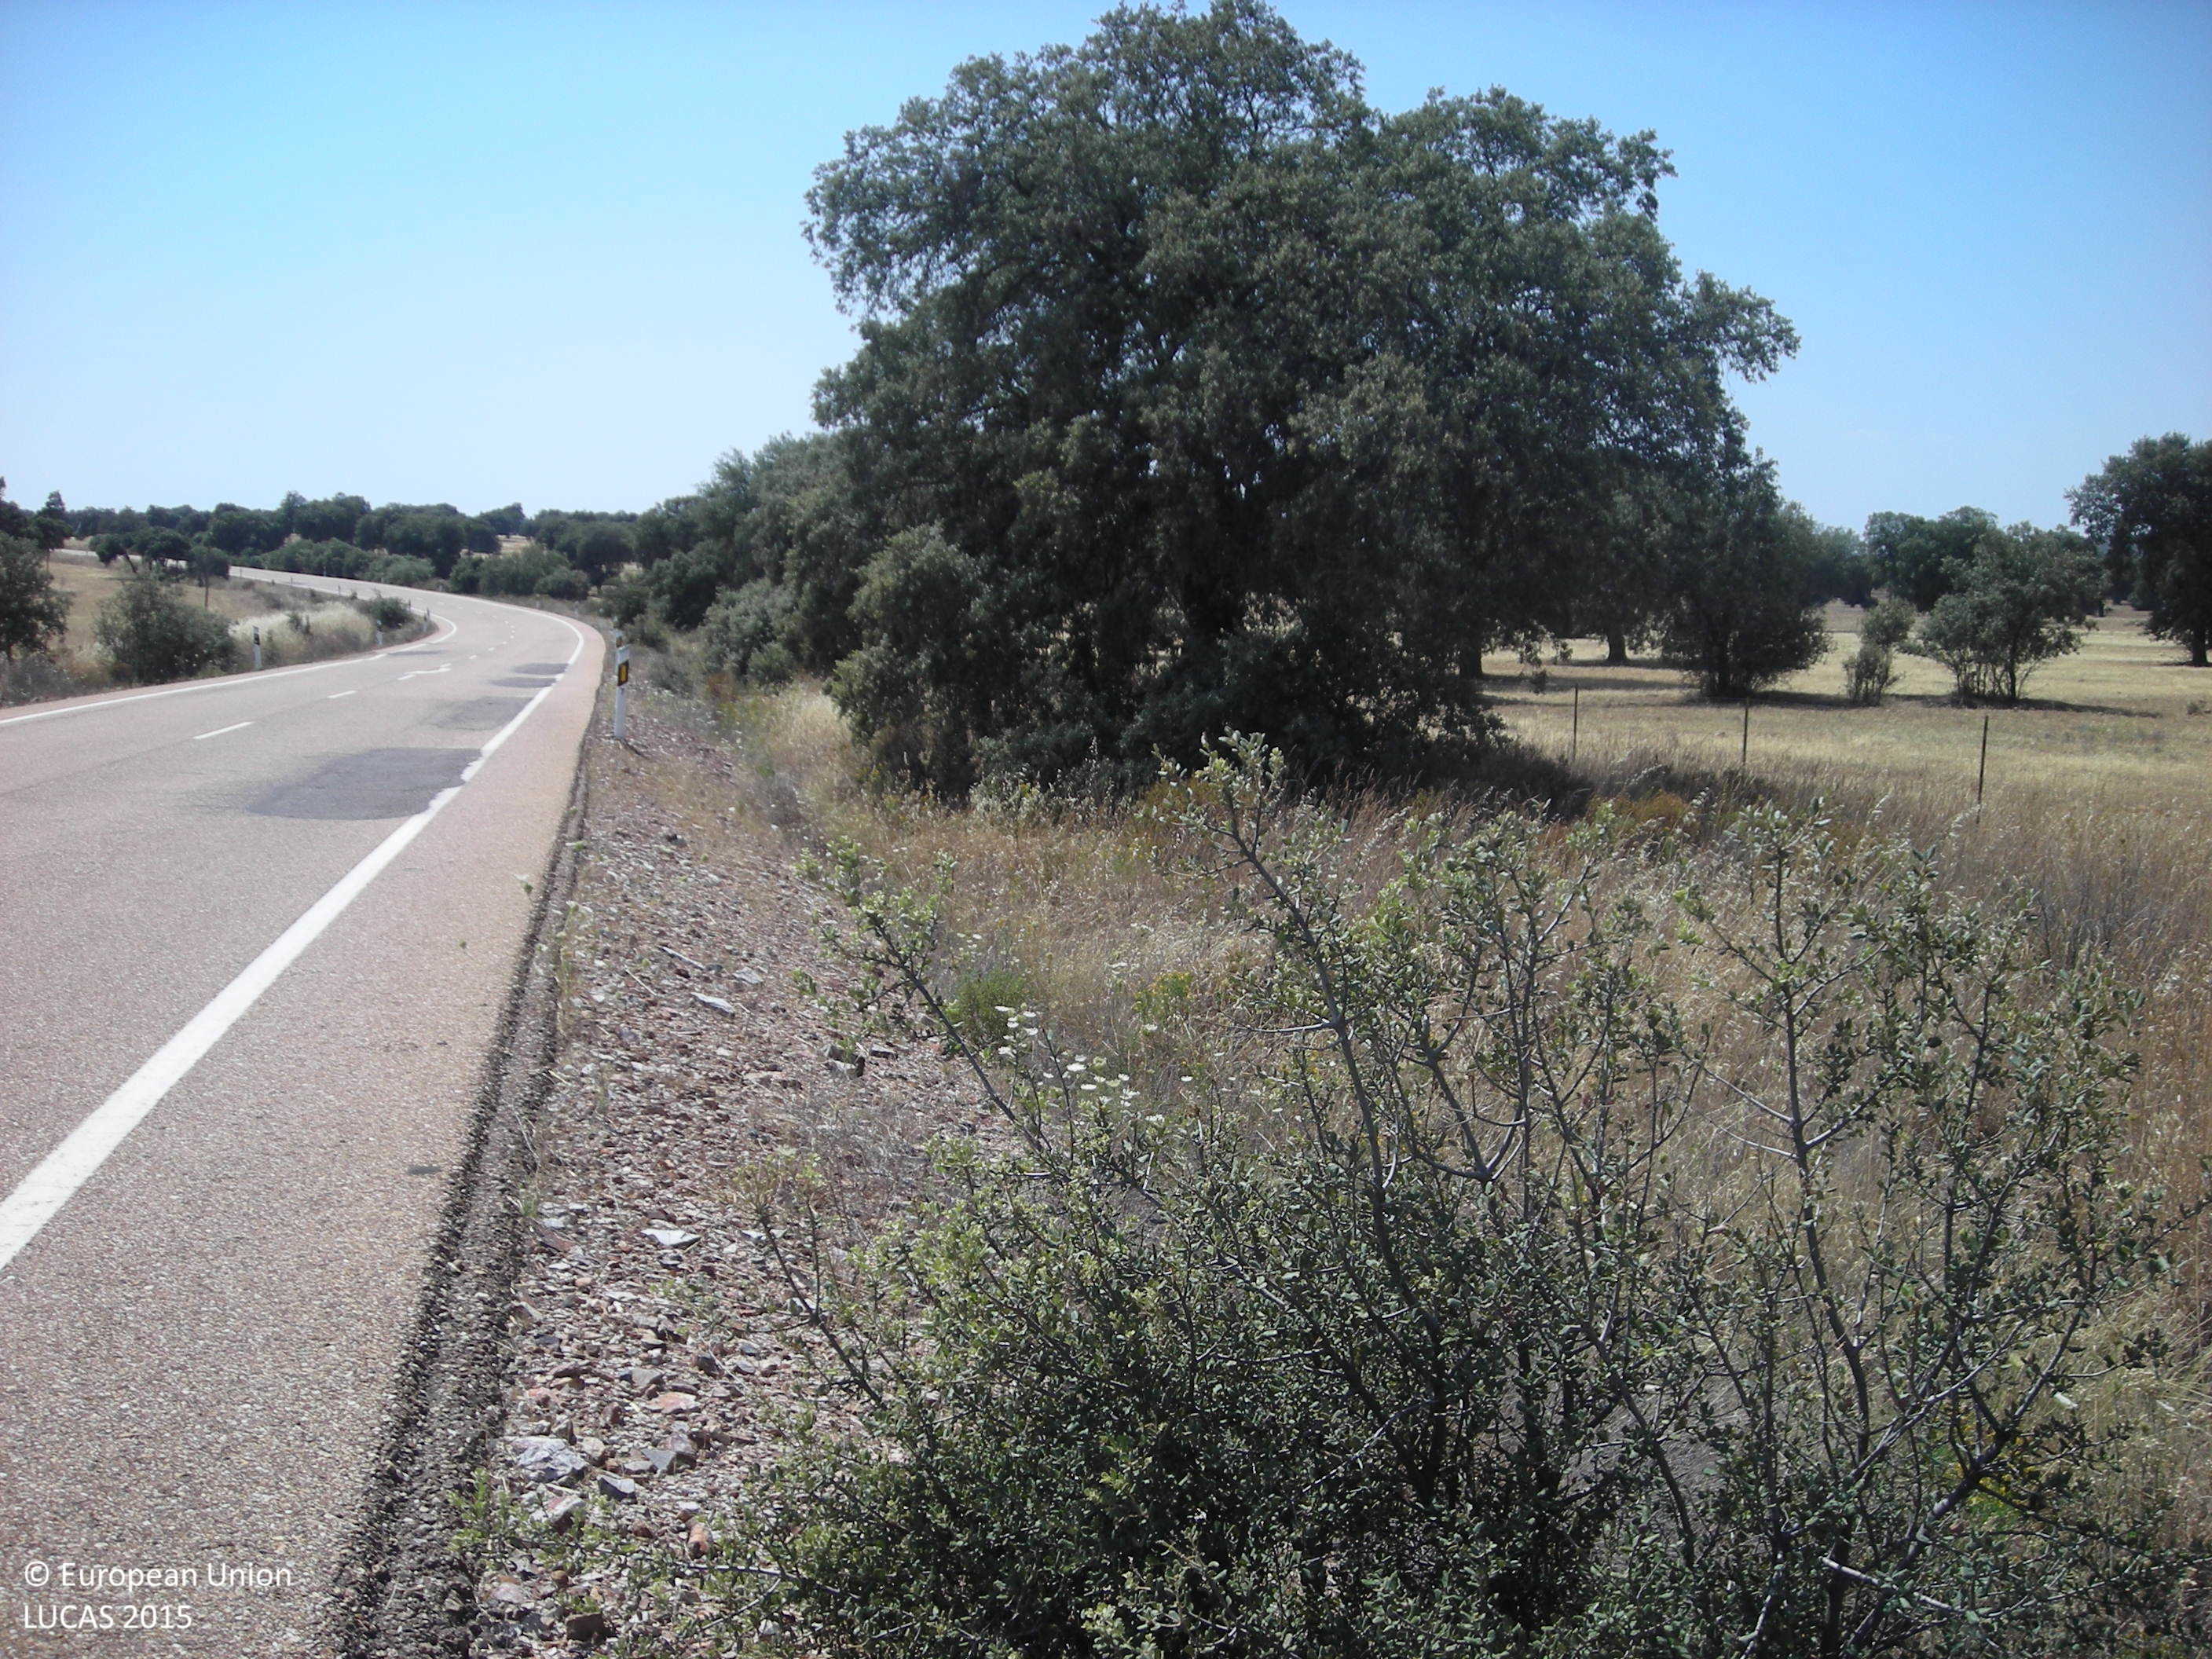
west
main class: Shrubland
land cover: Shrubland without tree cover
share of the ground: > 75 %
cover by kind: shrubs 100 %
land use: Semi-natural and natural areas not in use
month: June
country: ES
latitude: 38.6501
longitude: -5.8897
